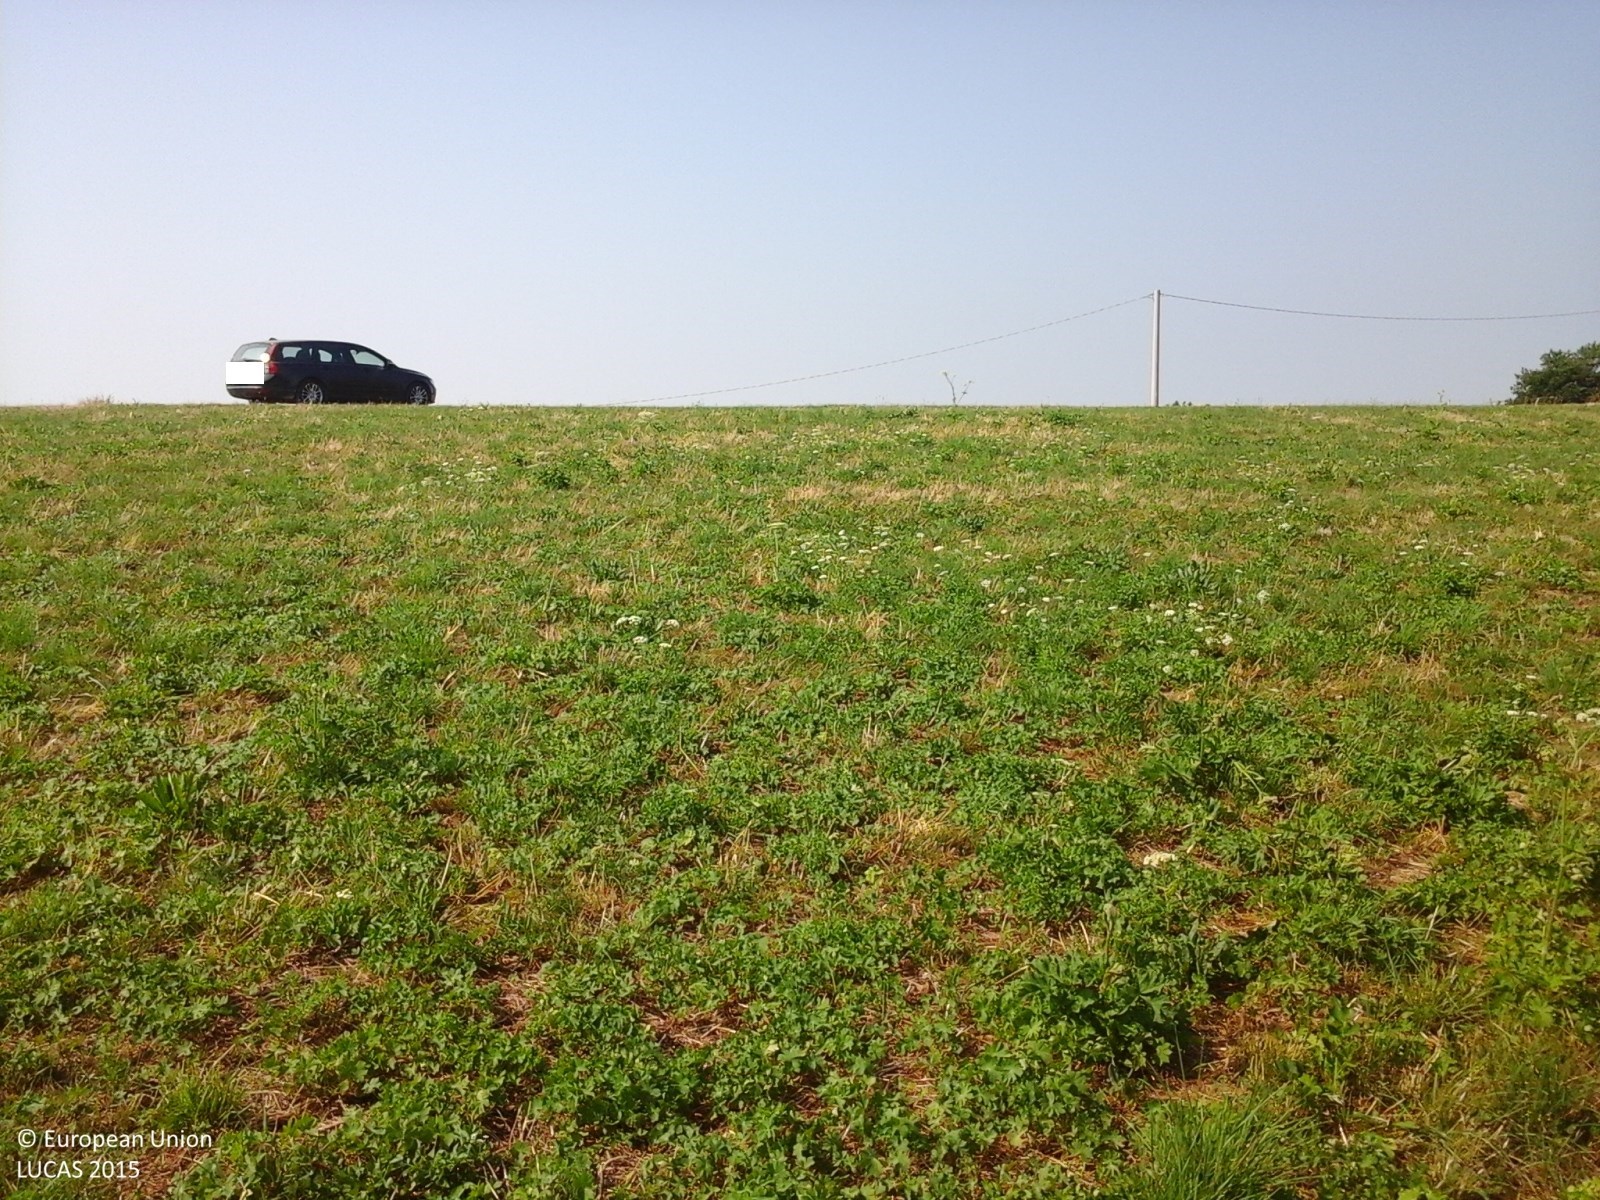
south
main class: Grassland
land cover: Grassland without tree/shrub cover
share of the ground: > 75 %
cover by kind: herbaceous plants 100 %
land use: Agriculture (excluding fallow land and kitchen gardens)
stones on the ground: < 10 %
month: July
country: IT
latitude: 45.6069
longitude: 11.0881
